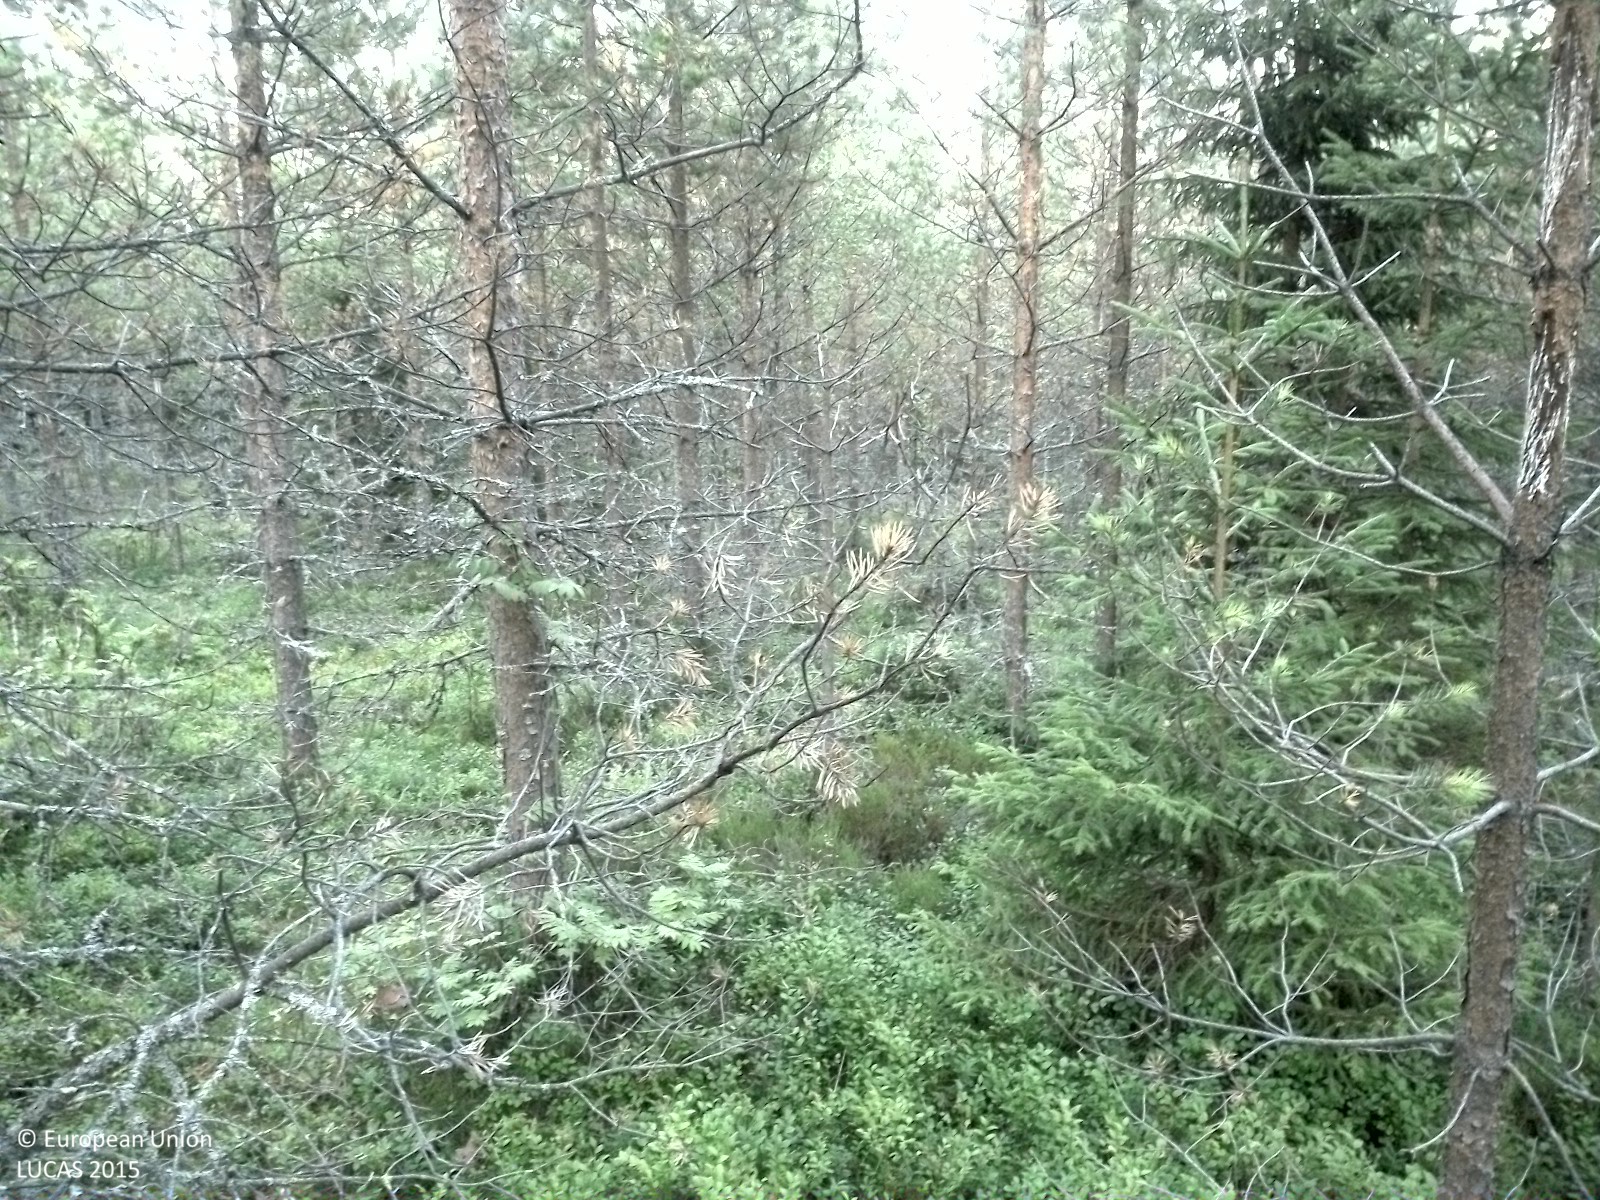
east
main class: Woodland
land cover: Pine dominated coniferous woodland
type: boreal forest
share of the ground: > 75 %
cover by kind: coniferous forest trees 60 %, shrubs 35 %, broadleaved forest trees 5 %
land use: Forestry
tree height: > 5 m
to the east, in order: Pine dominated coniferous woodland; Other coniferous woodland; Spruce dominated mixed woodland
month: August
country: SE
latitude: 62.5959
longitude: 17.7116
